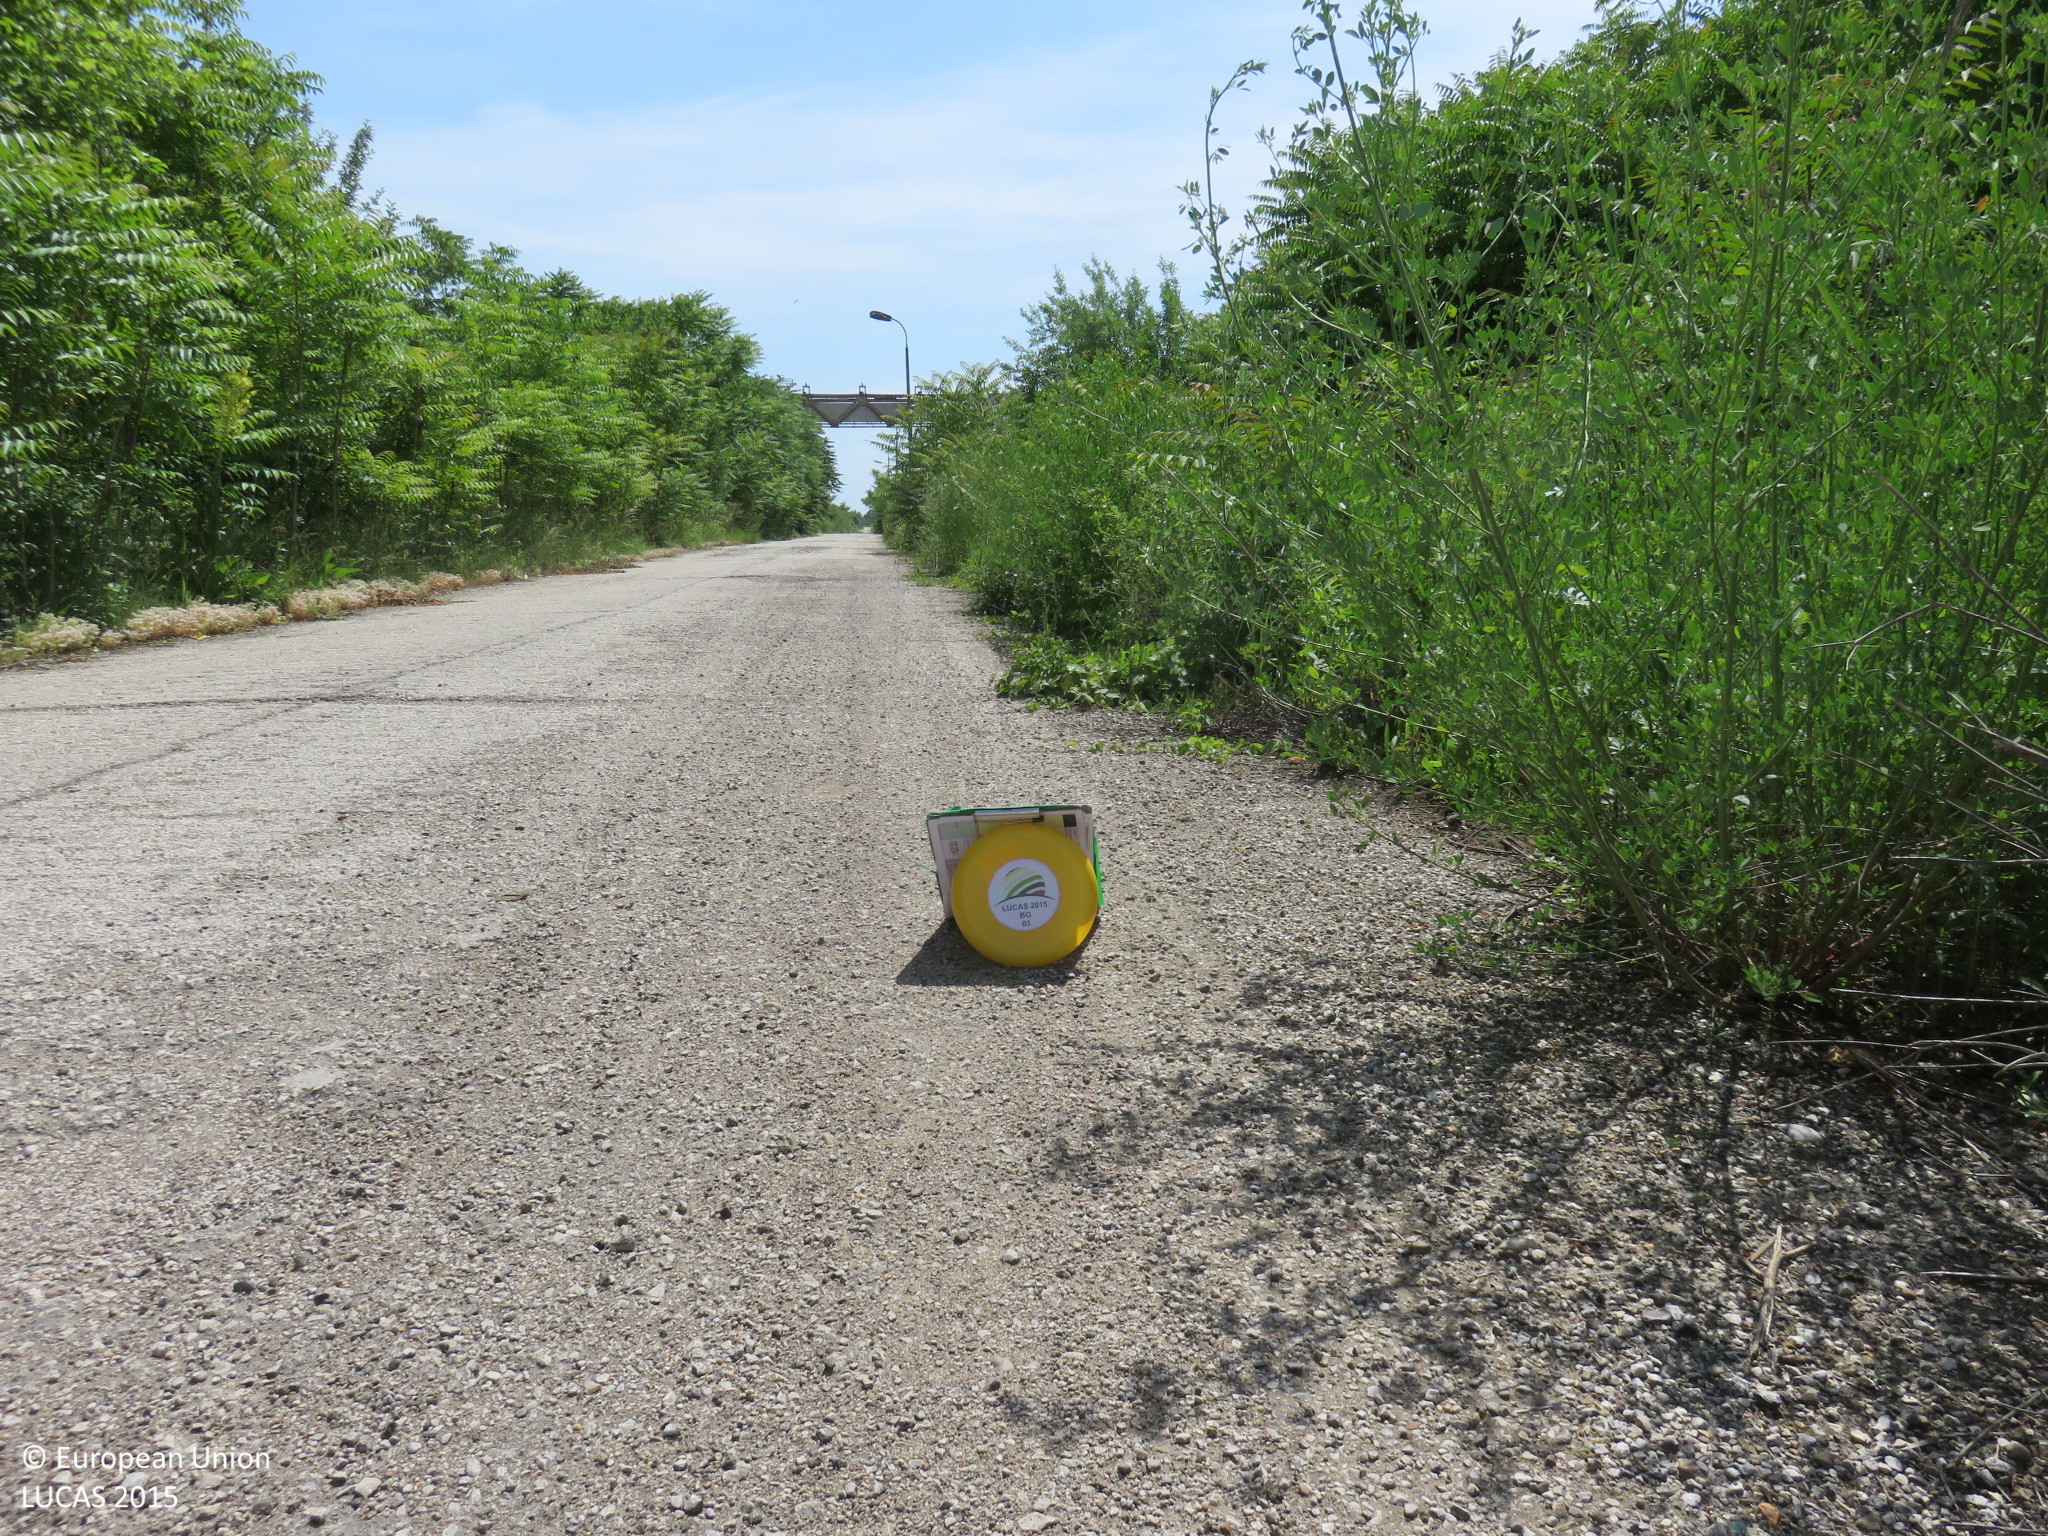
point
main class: Woodland
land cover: Broadleaved woodland
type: mesophytic deciduous forest
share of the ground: > 75 %
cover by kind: broadleaved forest trees 80 %, shrubs 15 %, herbaceous plants 5 %
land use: Semi-natural and natural areas not in use
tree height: < 5 m
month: June
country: BG
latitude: 43.3998
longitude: 24.4942
